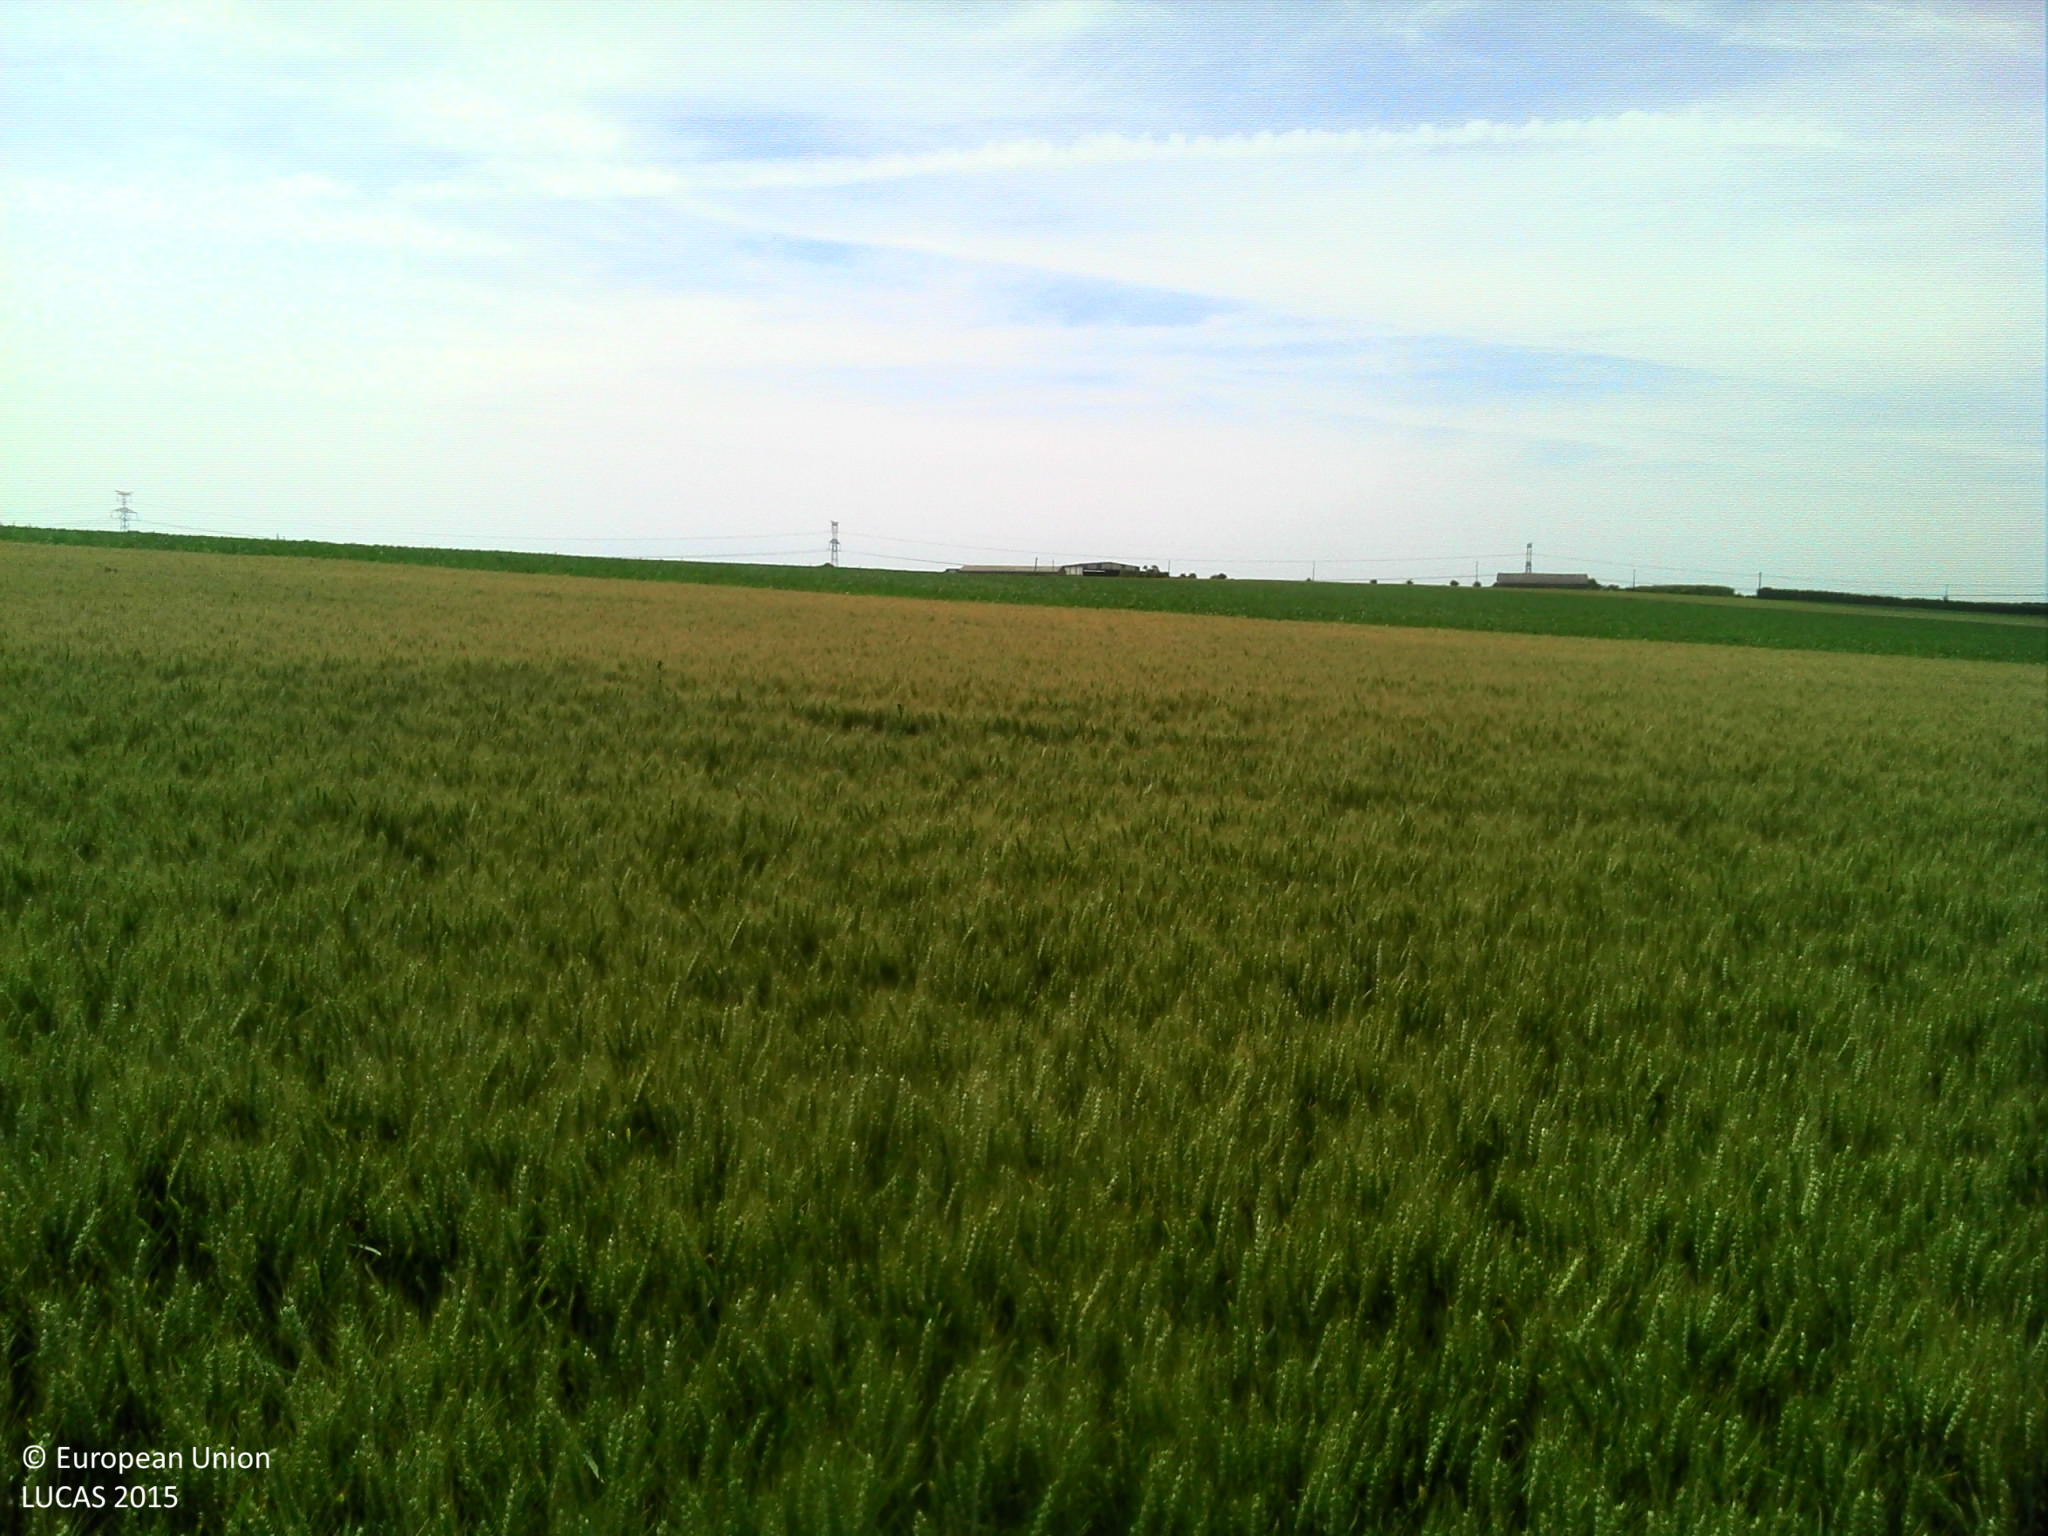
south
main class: Cropland
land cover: Common wheat
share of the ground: > 75 %
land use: Agriculture (excluding fallow land and kitchen gardens)
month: June
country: FR
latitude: 49.1159
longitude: -0.3236
